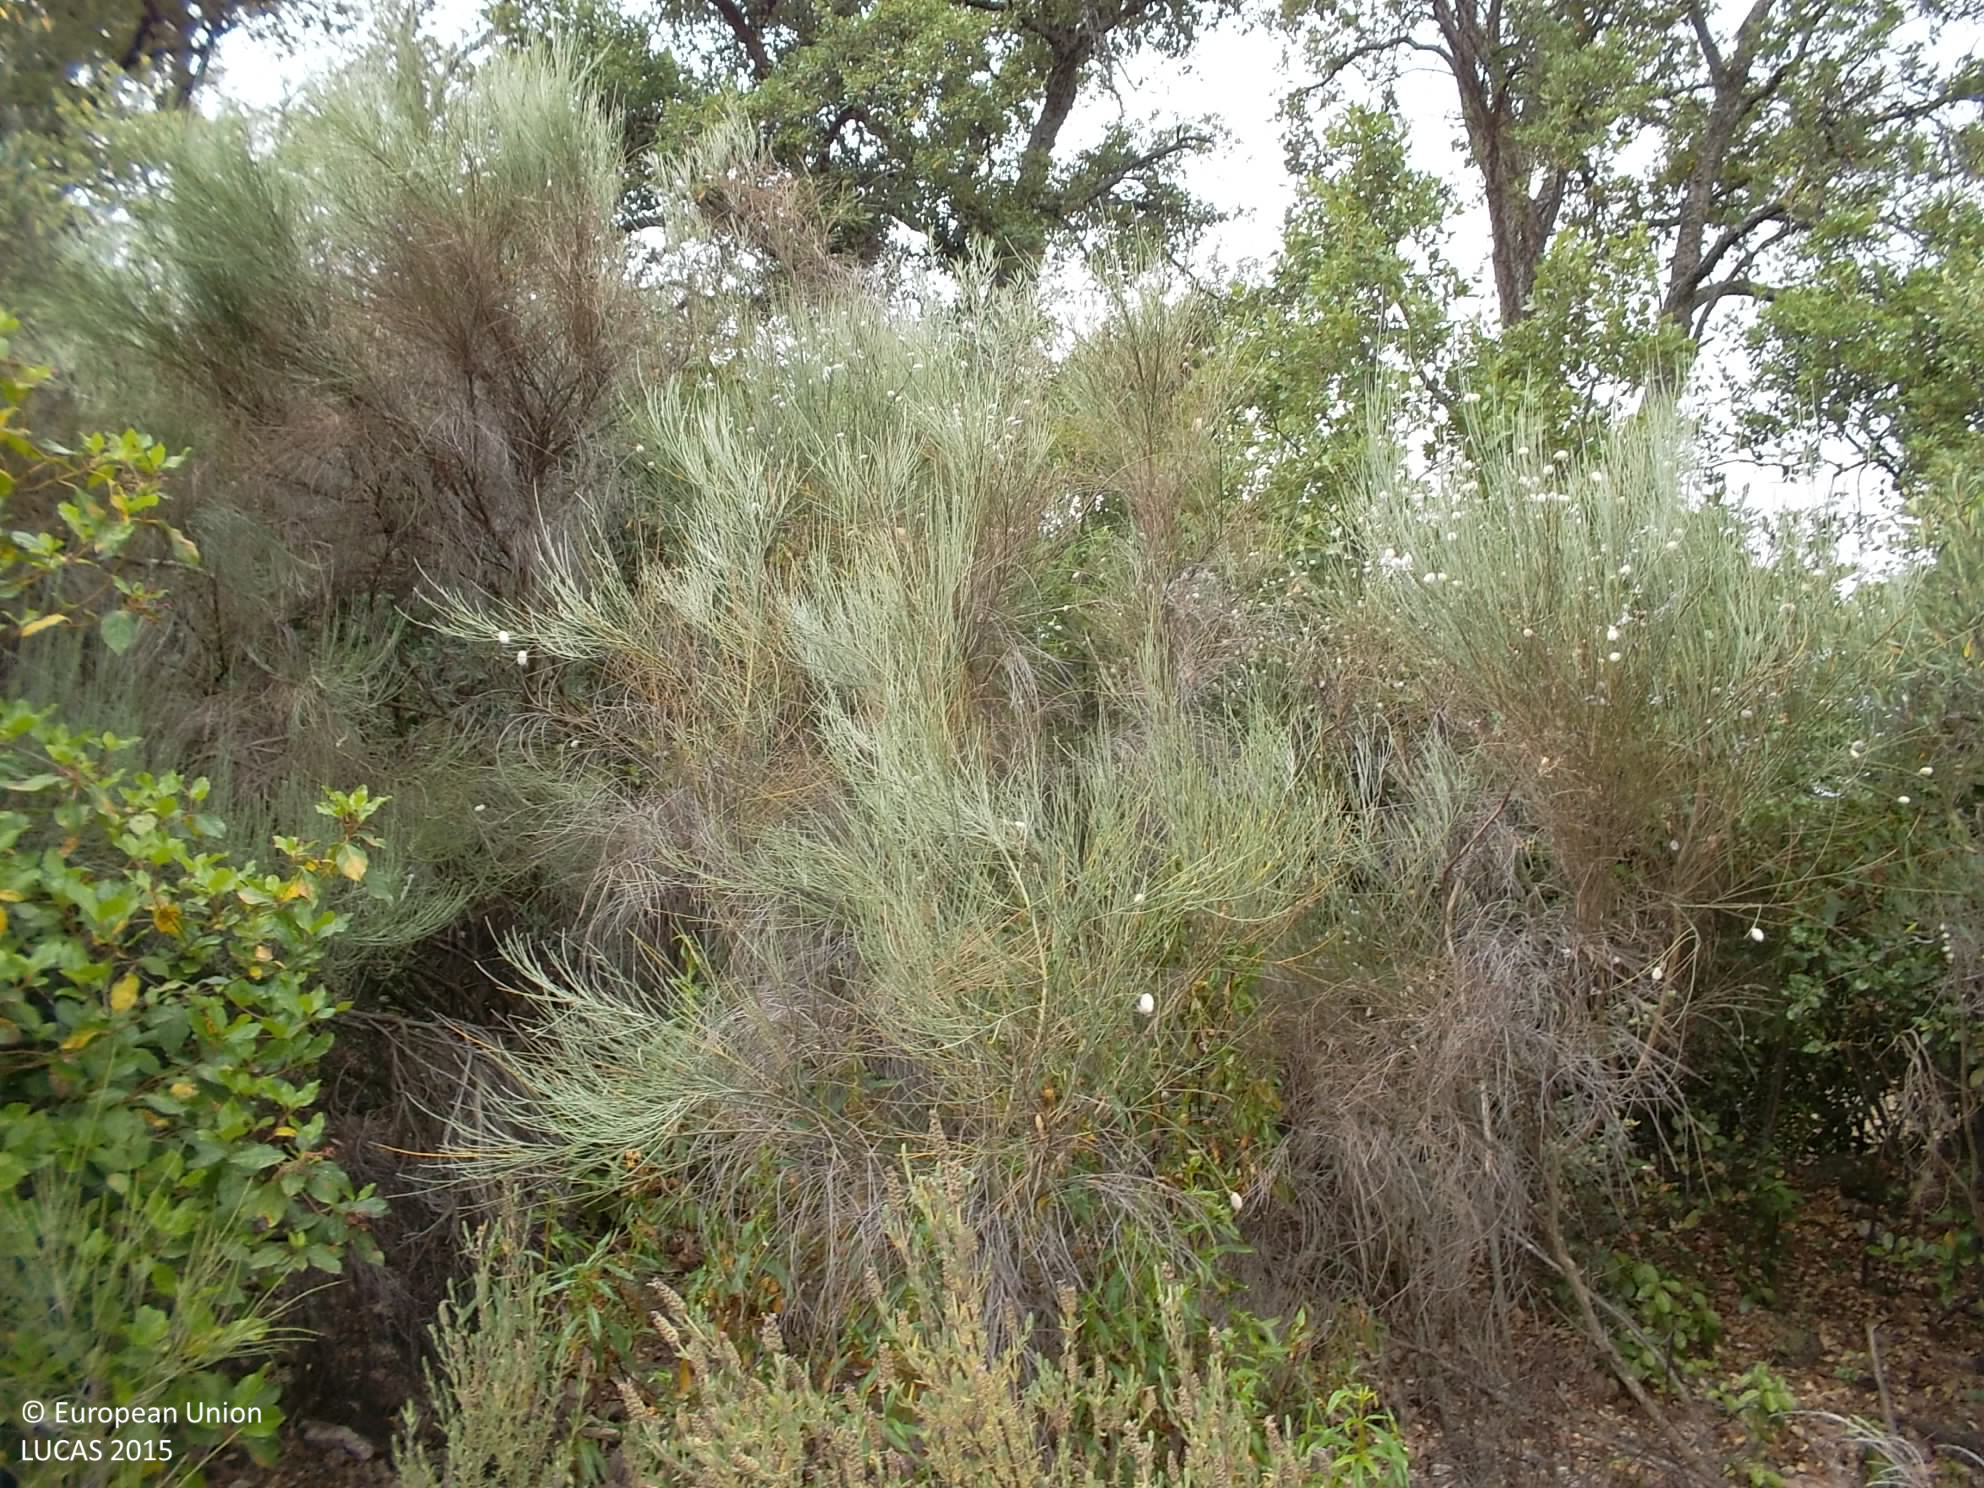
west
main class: Cropland
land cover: Olive groves
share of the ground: 25 - 50 %
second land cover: Shrubland without tree cover
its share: 50 - 75 %
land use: Agriculture (excluding fallow land and kitchen gardens)
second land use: Forestry
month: June
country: ES
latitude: 39.2111
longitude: -4.8019
